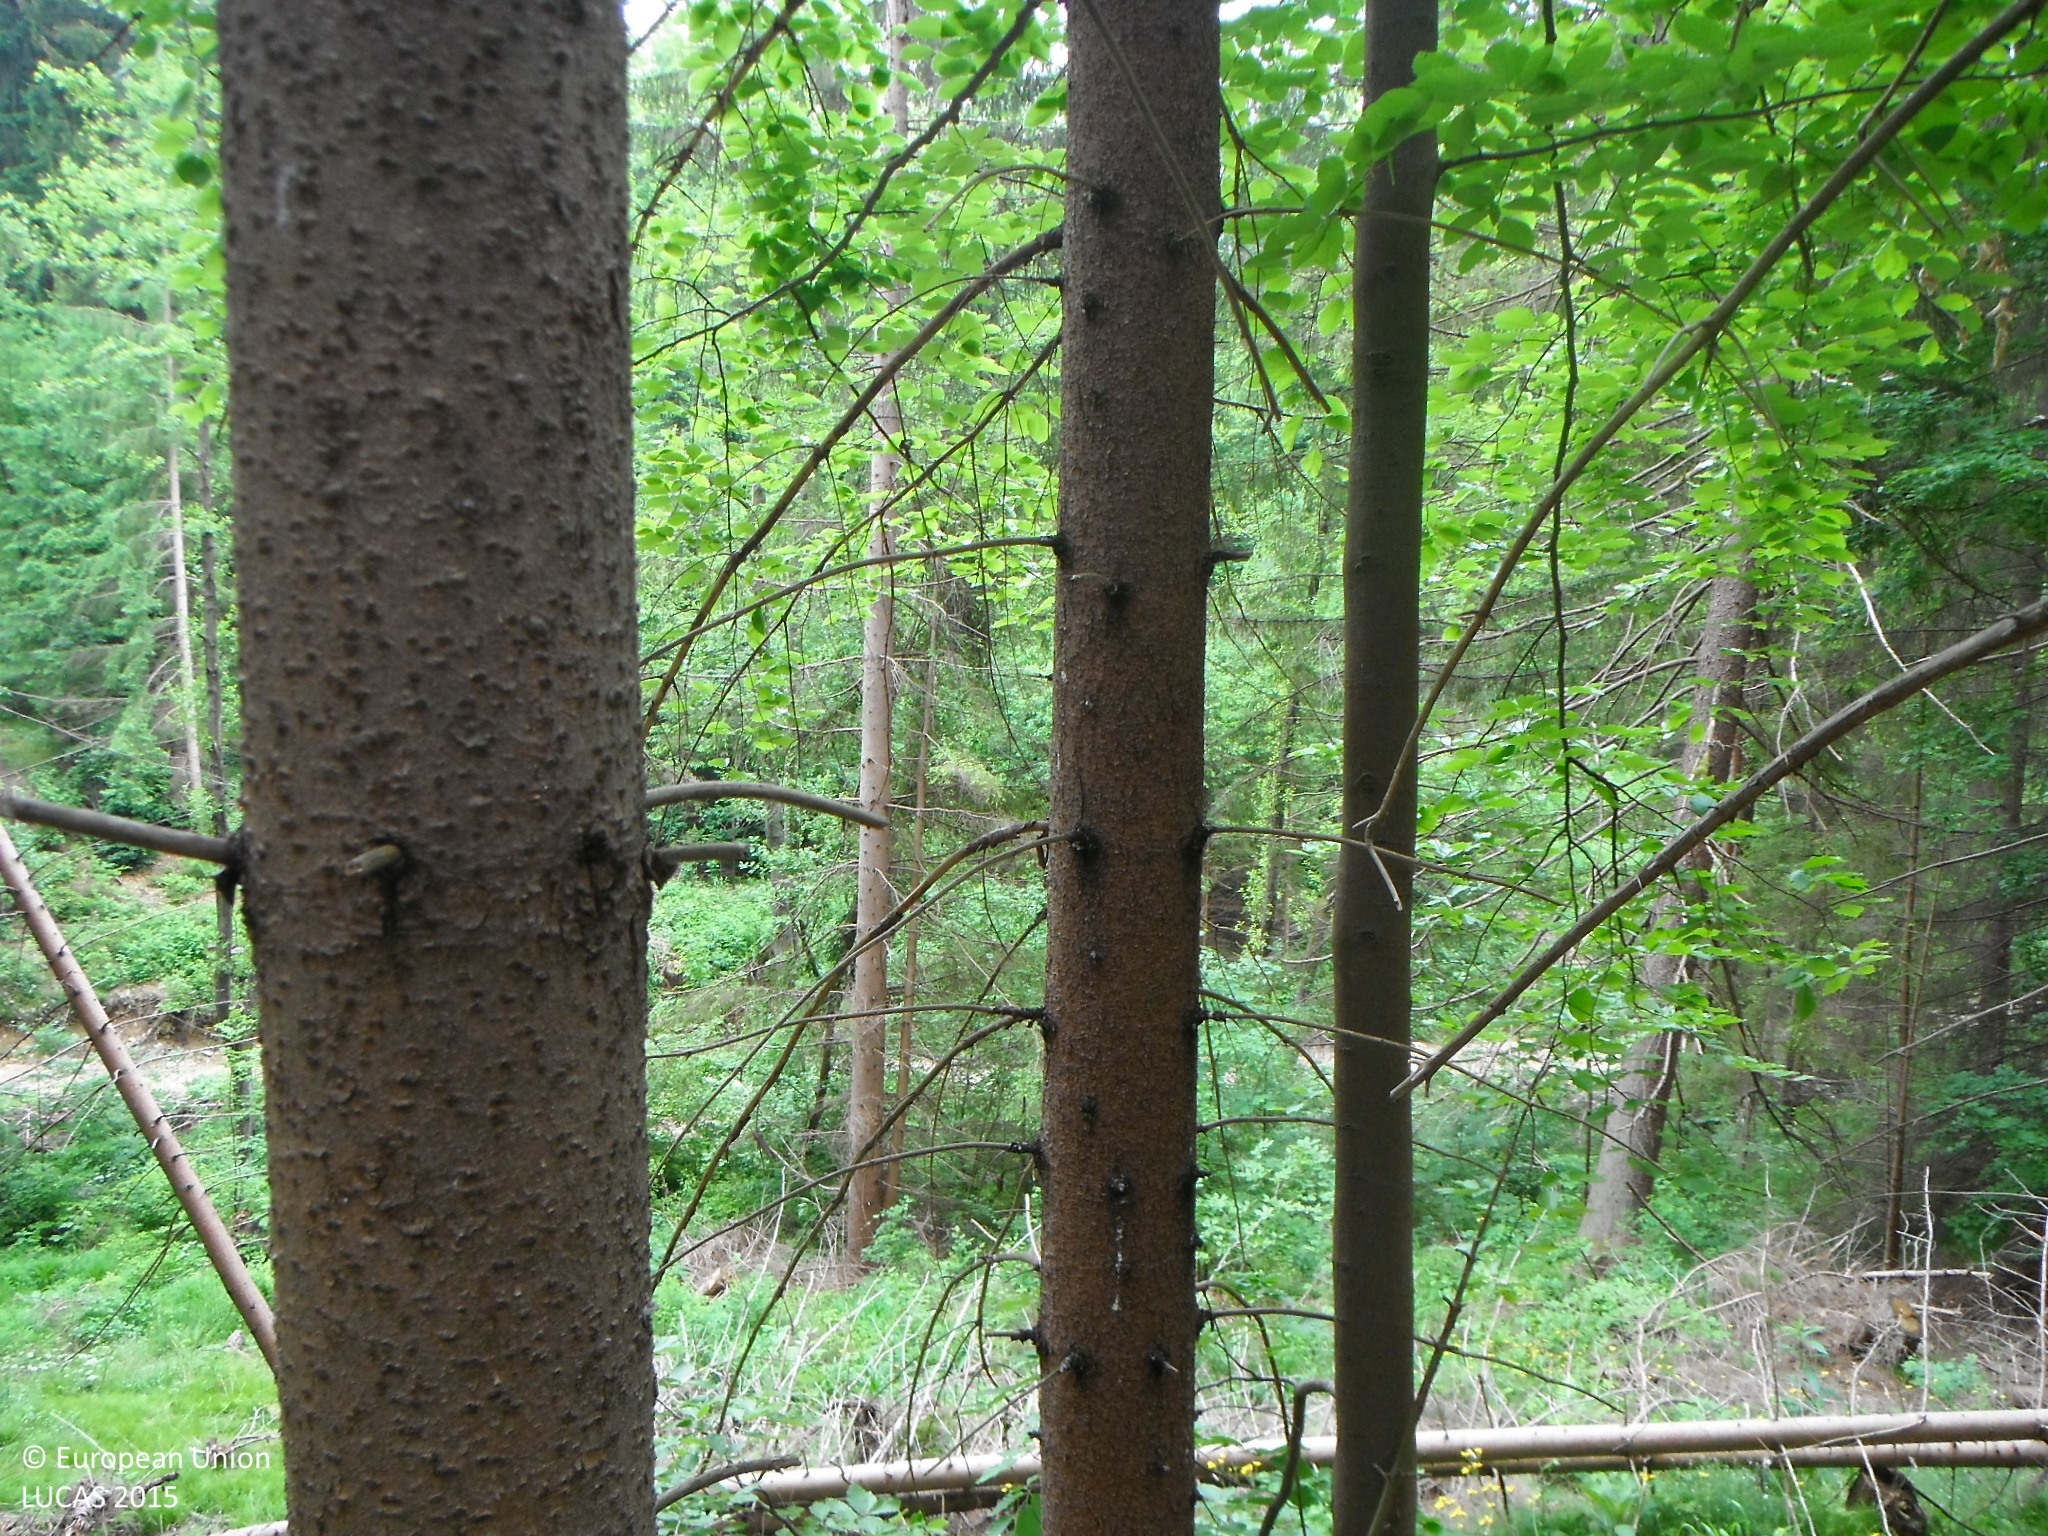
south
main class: Woodland
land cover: Spruce dominated coniferous woodland
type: alpine coniferous forest
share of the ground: > 75 %
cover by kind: coniferous forest trees 95 %, broadleaved forest trees 5 %
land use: Forestry
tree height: > 5 m
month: June
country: SK
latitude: 48.7810
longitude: 19.4013
